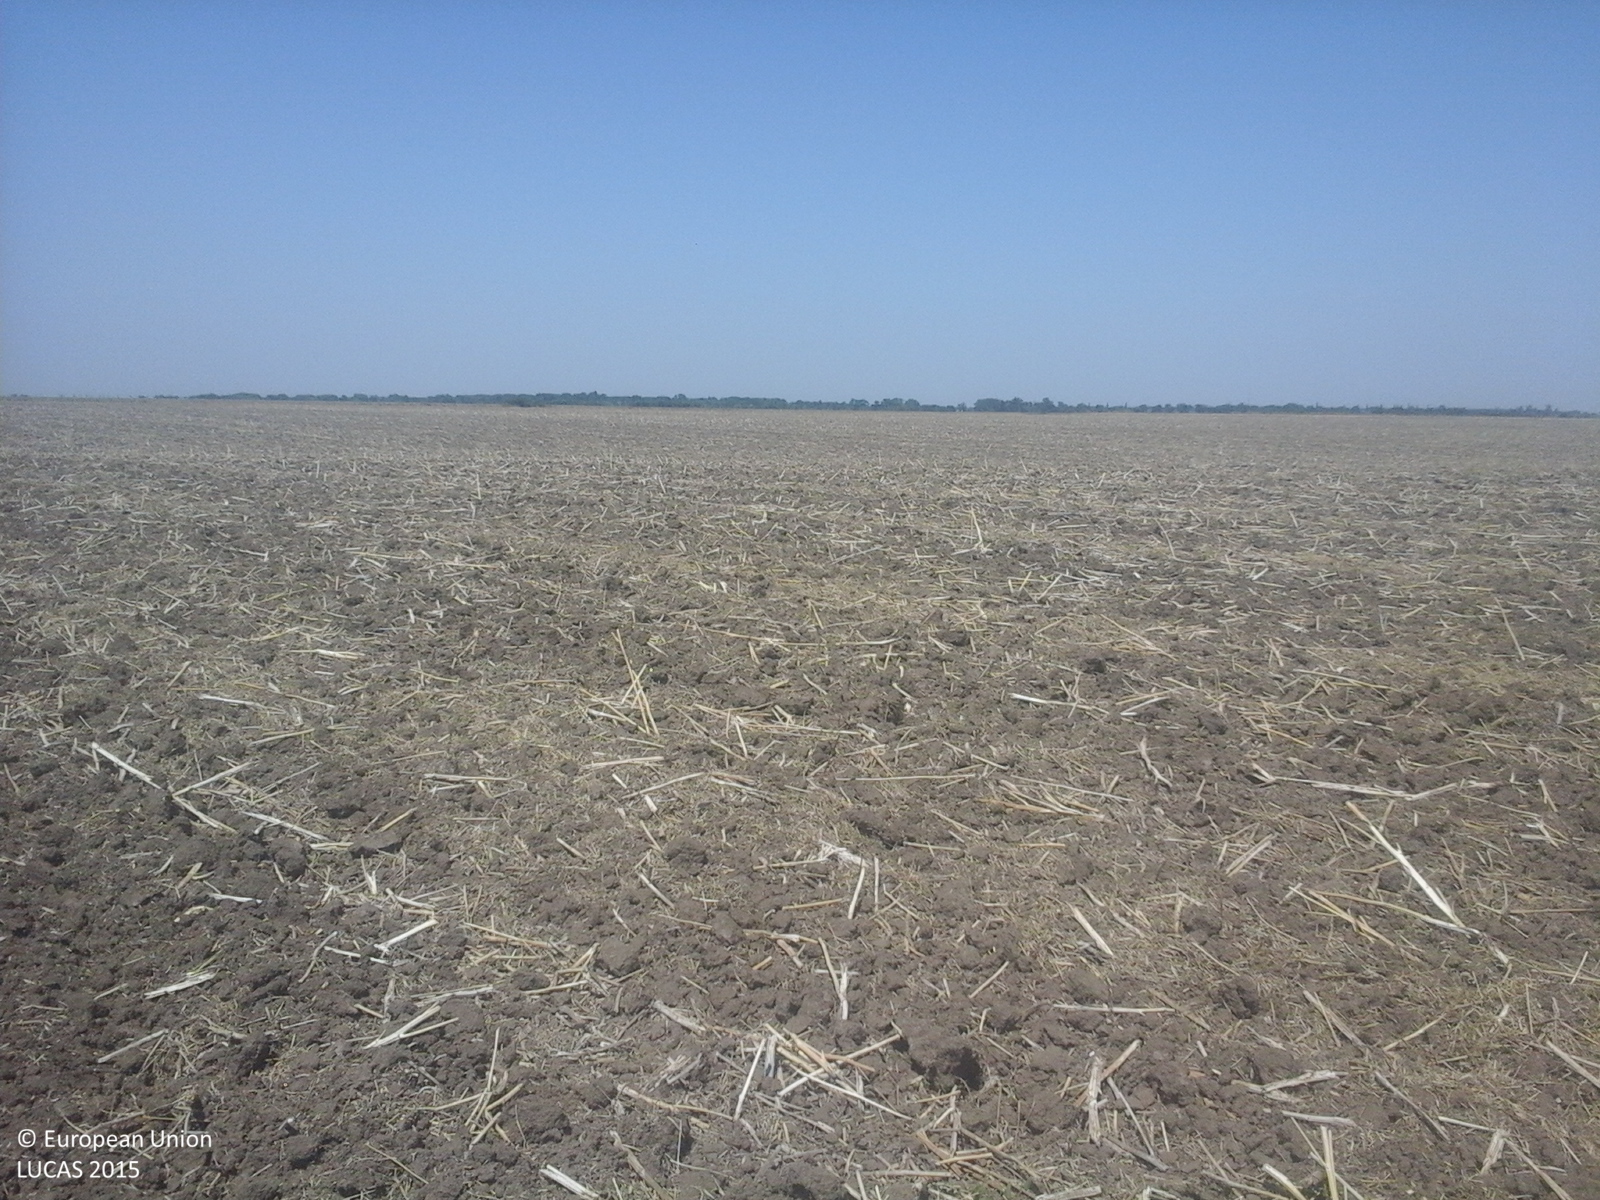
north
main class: Cropland
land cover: Rape and turnip rape
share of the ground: < 10 %
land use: Agriculture (excluding fallow land and kitchen gardens)
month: July
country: RO
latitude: 44.4139
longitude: 26.7358
